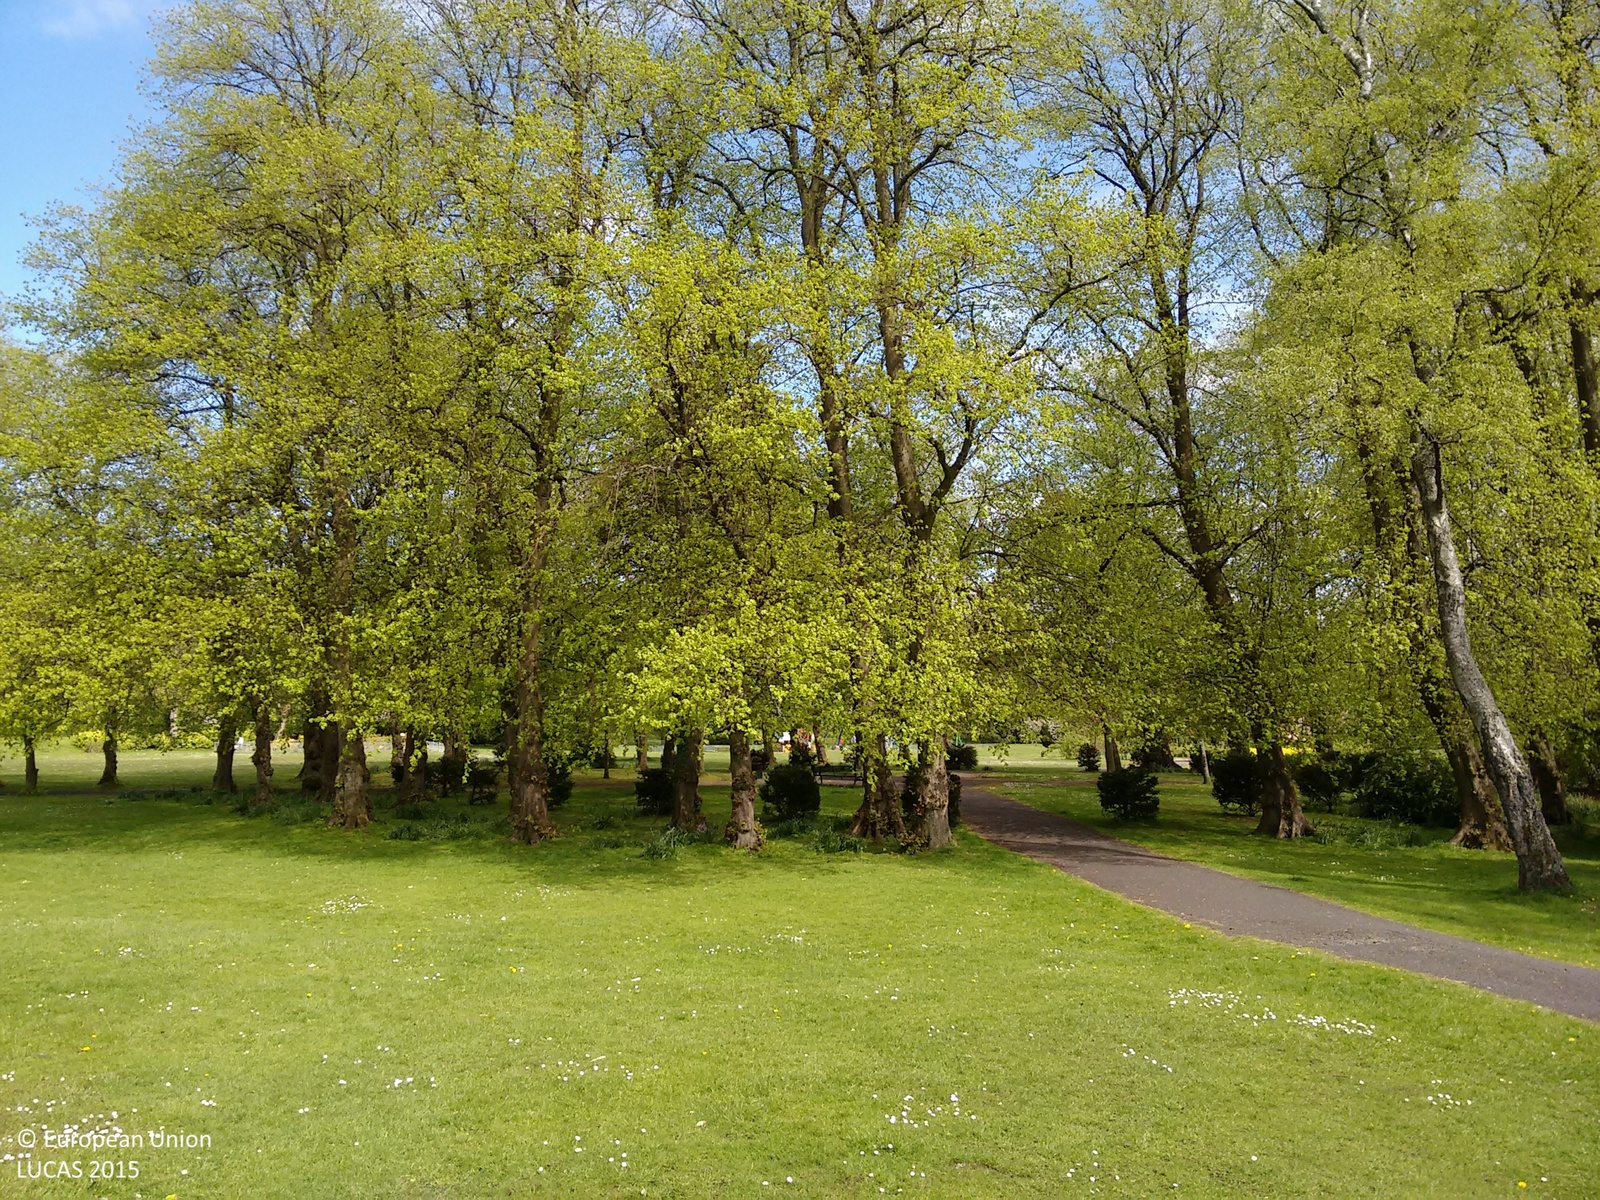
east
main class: Grassland
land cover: Grassland without tree/shrub cover
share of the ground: > 75 %
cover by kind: herbaceous plants 100 %
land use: Amenities, museums, leisure
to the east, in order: Grassland without tree/shrub cover; Broadleaved woodland; Managed hedges; Broadleaved woodland; Tracks; Broadleaved woodland; Grassland without tree/shrub cover; Artificial constructions in urban areas; Broadleaved woodland; Artificial constructions in urban areas
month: May
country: GB
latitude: 55.8395
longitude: -4.2901
